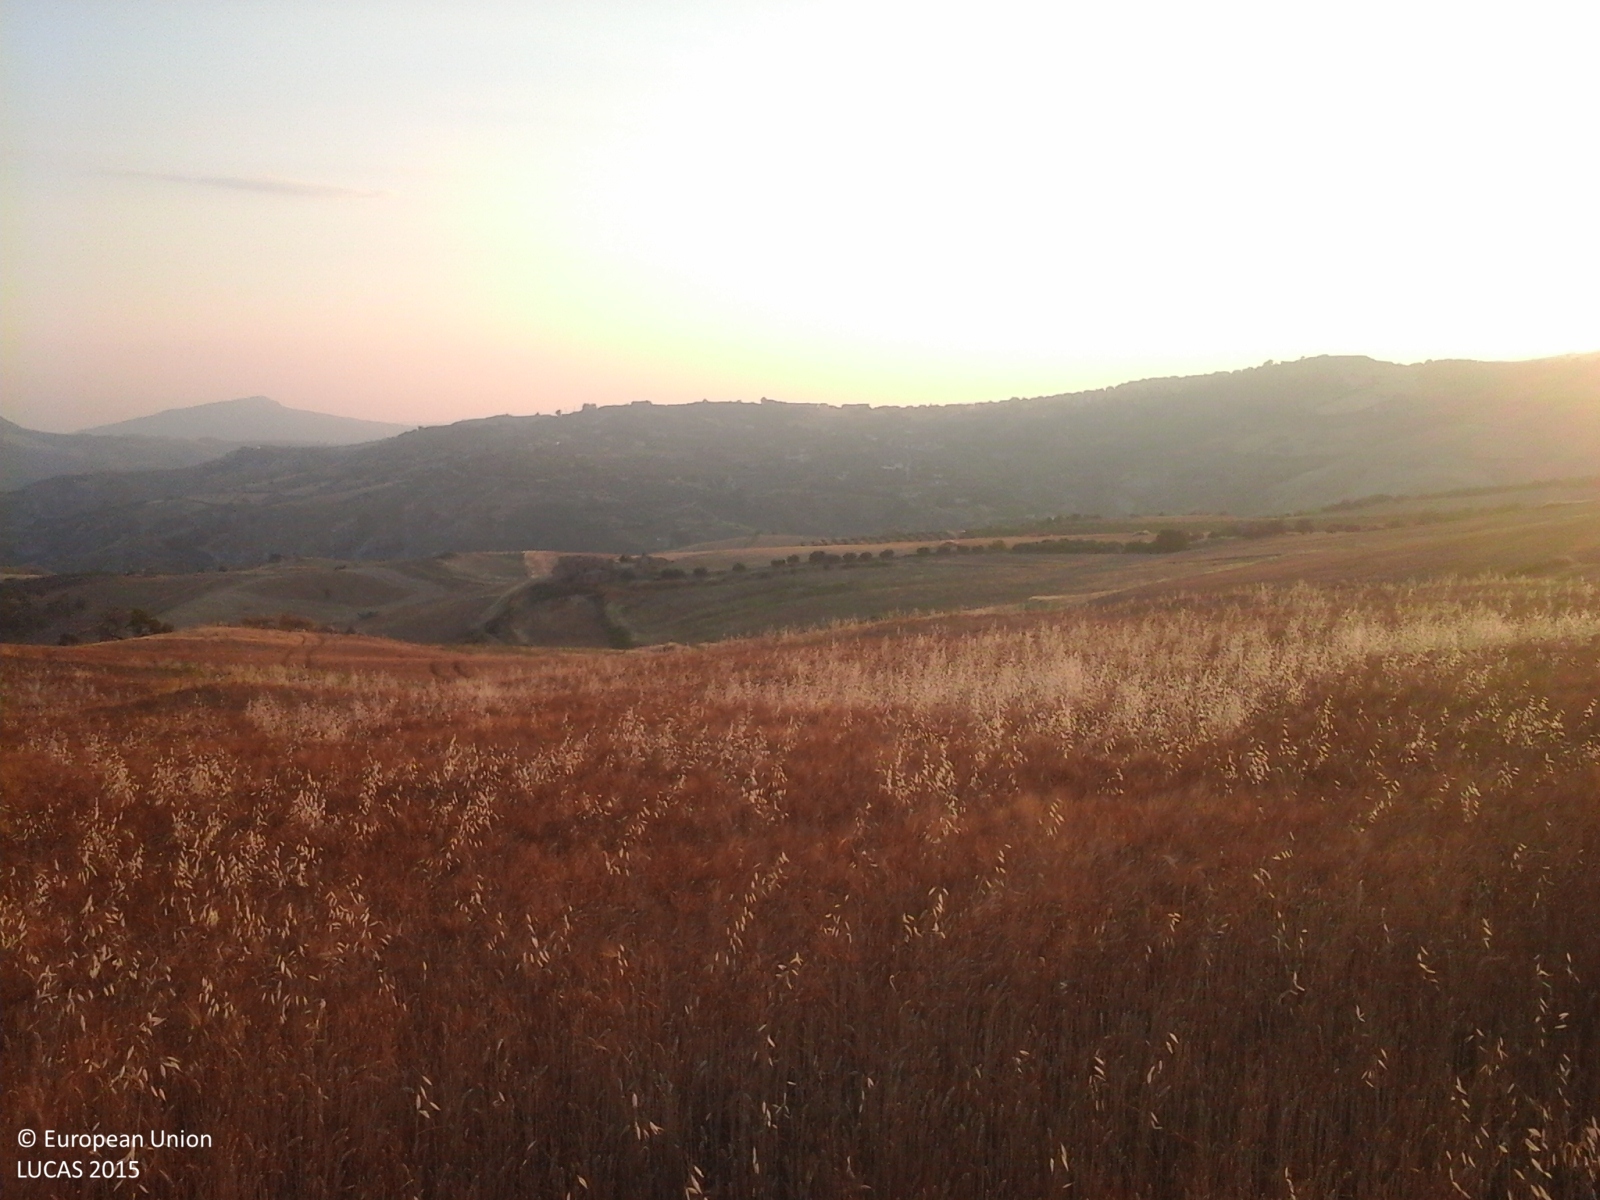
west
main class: Cropland
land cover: Durum wheat
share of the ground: > 75 %
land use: Agriculture (excluding fallow land and kitchen gardens)
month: July
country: IT
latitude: 37.5207
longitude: 13.4699
